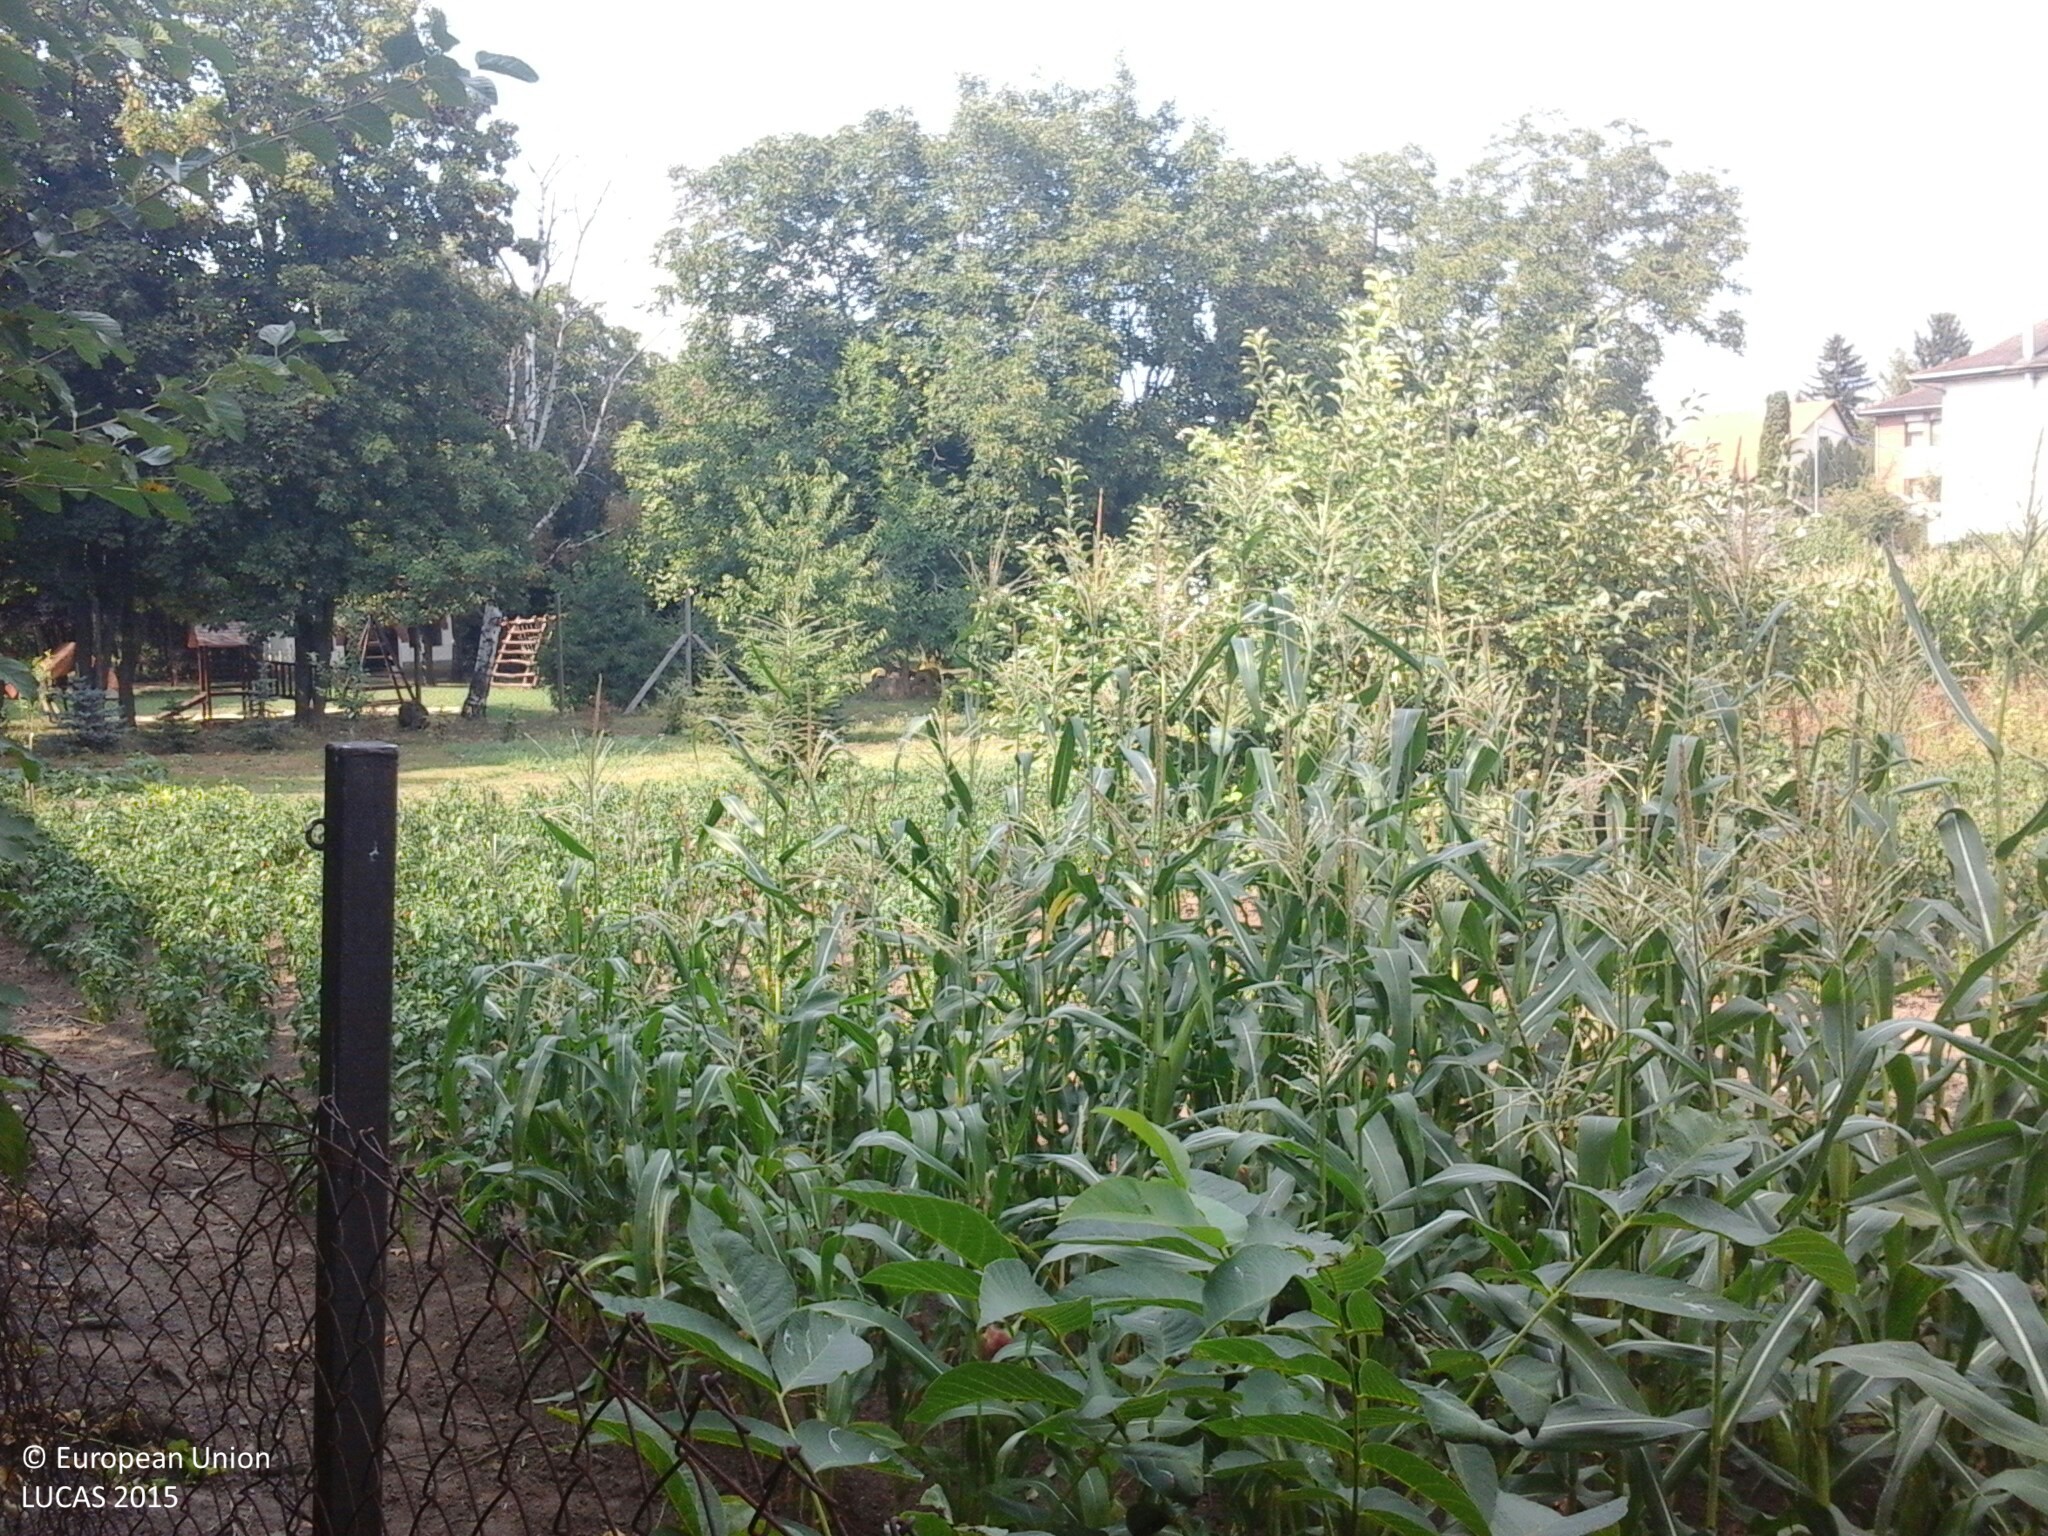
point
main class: Cropland
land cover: Other fresh vegetables
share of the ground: > 75 %
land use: Kitchen garden
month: August
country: HU
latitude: 46.8399
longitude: 18.3367
